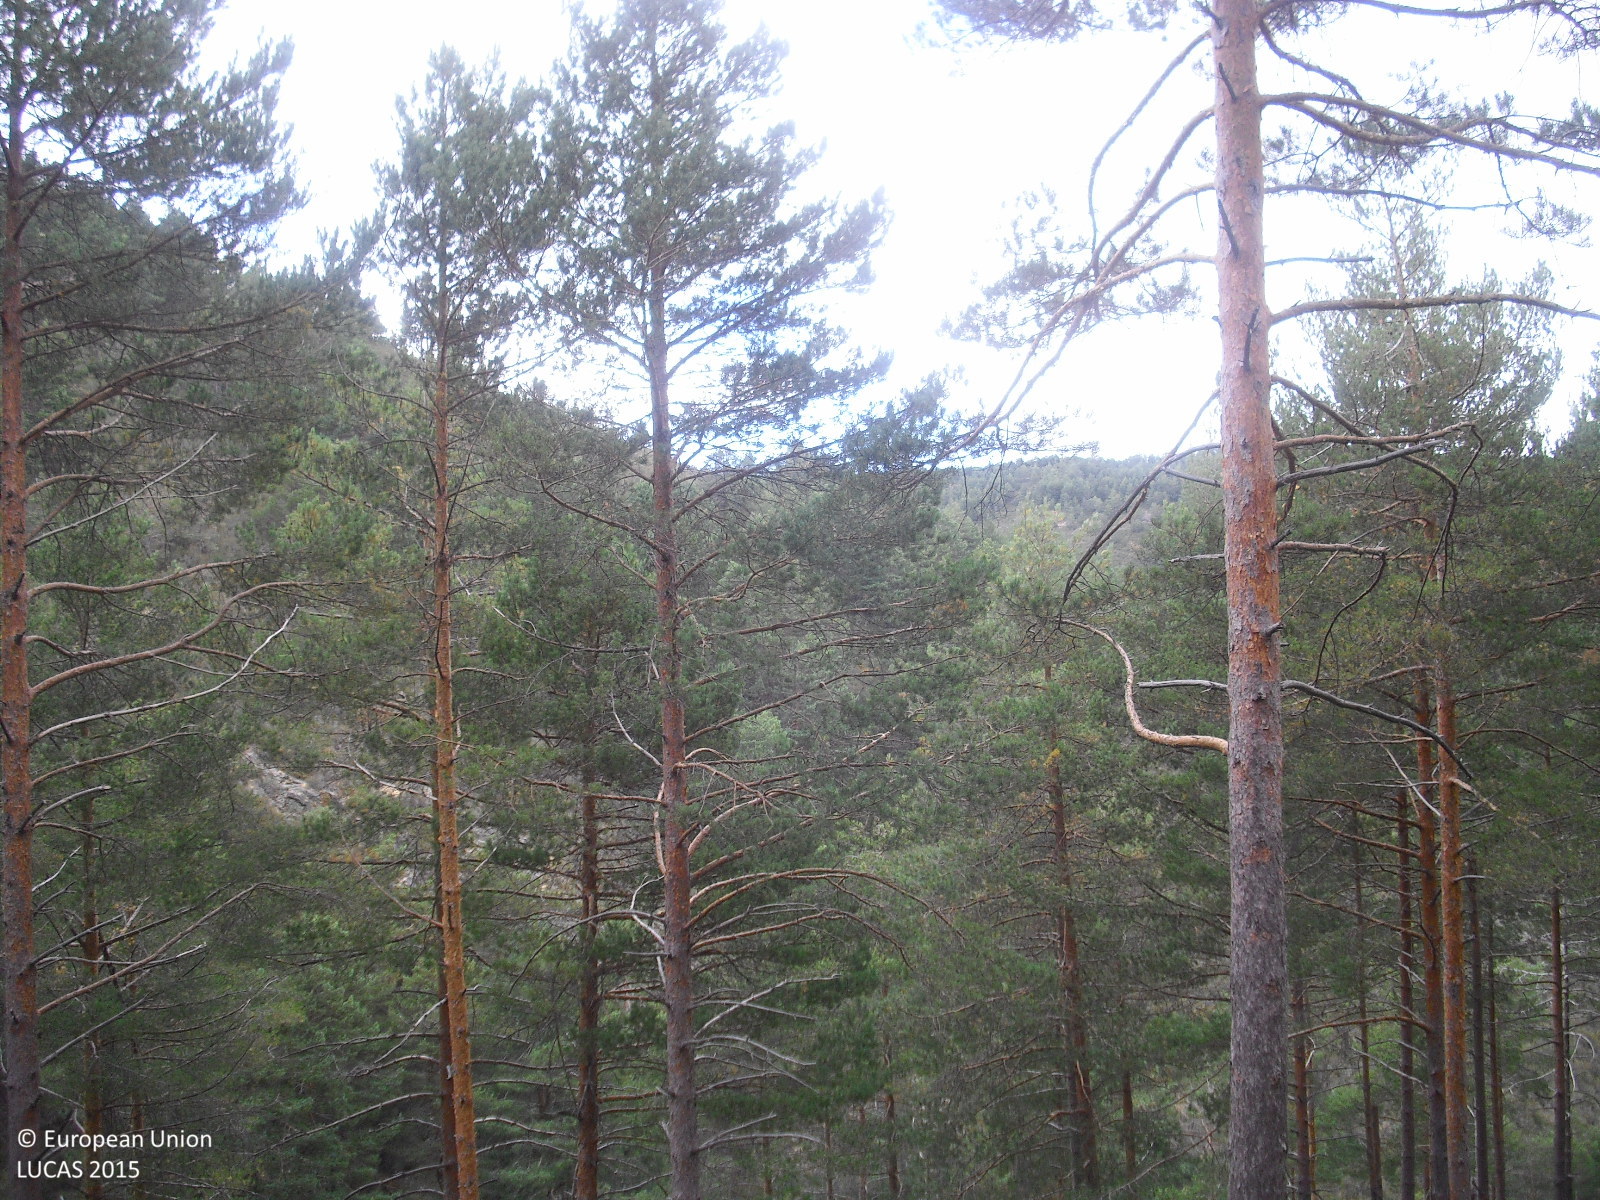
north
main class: Woodland
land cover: Pine dominated coniferous woodland
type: hemiboreal forest and nemoral coniferous forest and mixed broadleaved-coniferous forest
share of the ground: 25 - 50 %
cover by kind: shrubs 70 %, coniferous forest trees 30 %
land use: Forestry
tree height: > 5 m
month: August
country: ES
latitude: 42.1033
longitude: -7.3396
